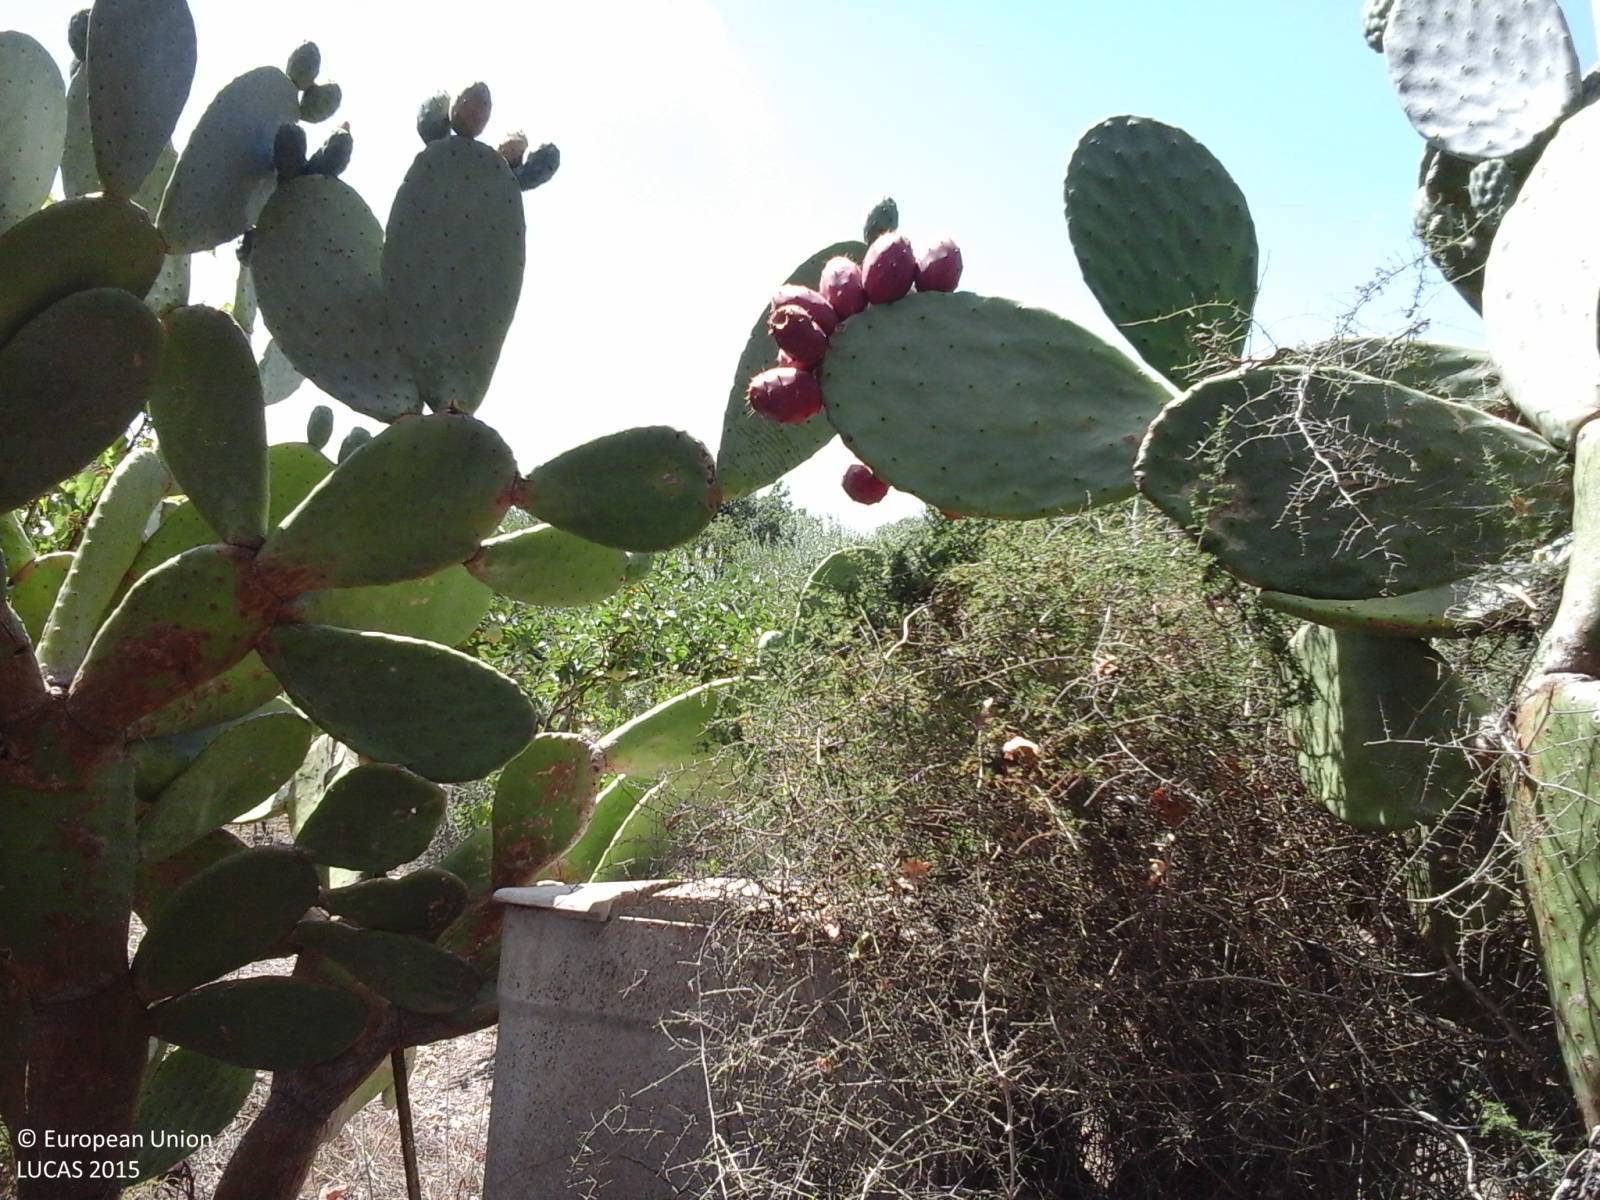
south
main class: Cropland
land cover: Olive groves
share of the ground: > 75 %
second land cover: Grassland without tree/shrub cover
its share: > 75 %
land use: Agriculture (excluding fallow land and kitchen gardens)
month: August
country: IT
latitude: 40.1162
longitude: 8.8913
